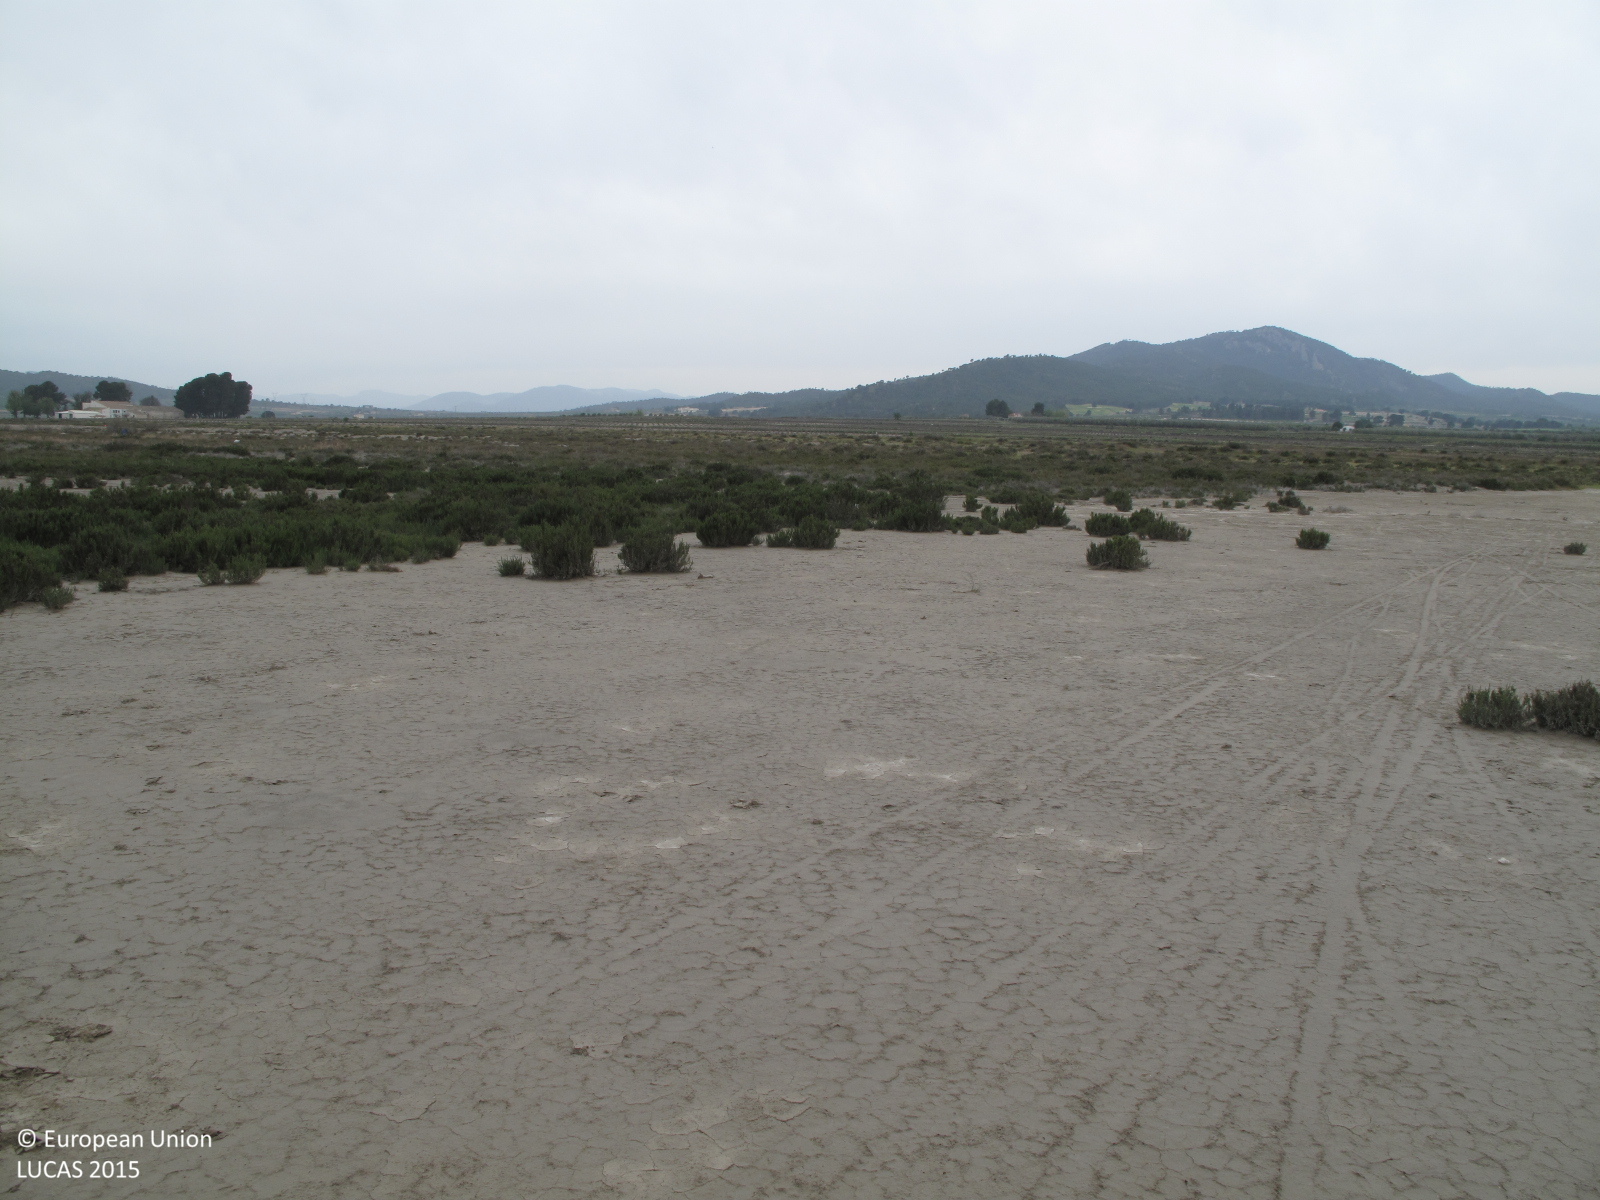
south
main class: Bare land
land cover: Sand
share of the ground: > 75 %
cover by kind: unconsolidated bare surface 100 %
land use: Semi-natural and natural areas not in use
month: April
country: ES
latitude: 38.5087
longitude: -0.8948
